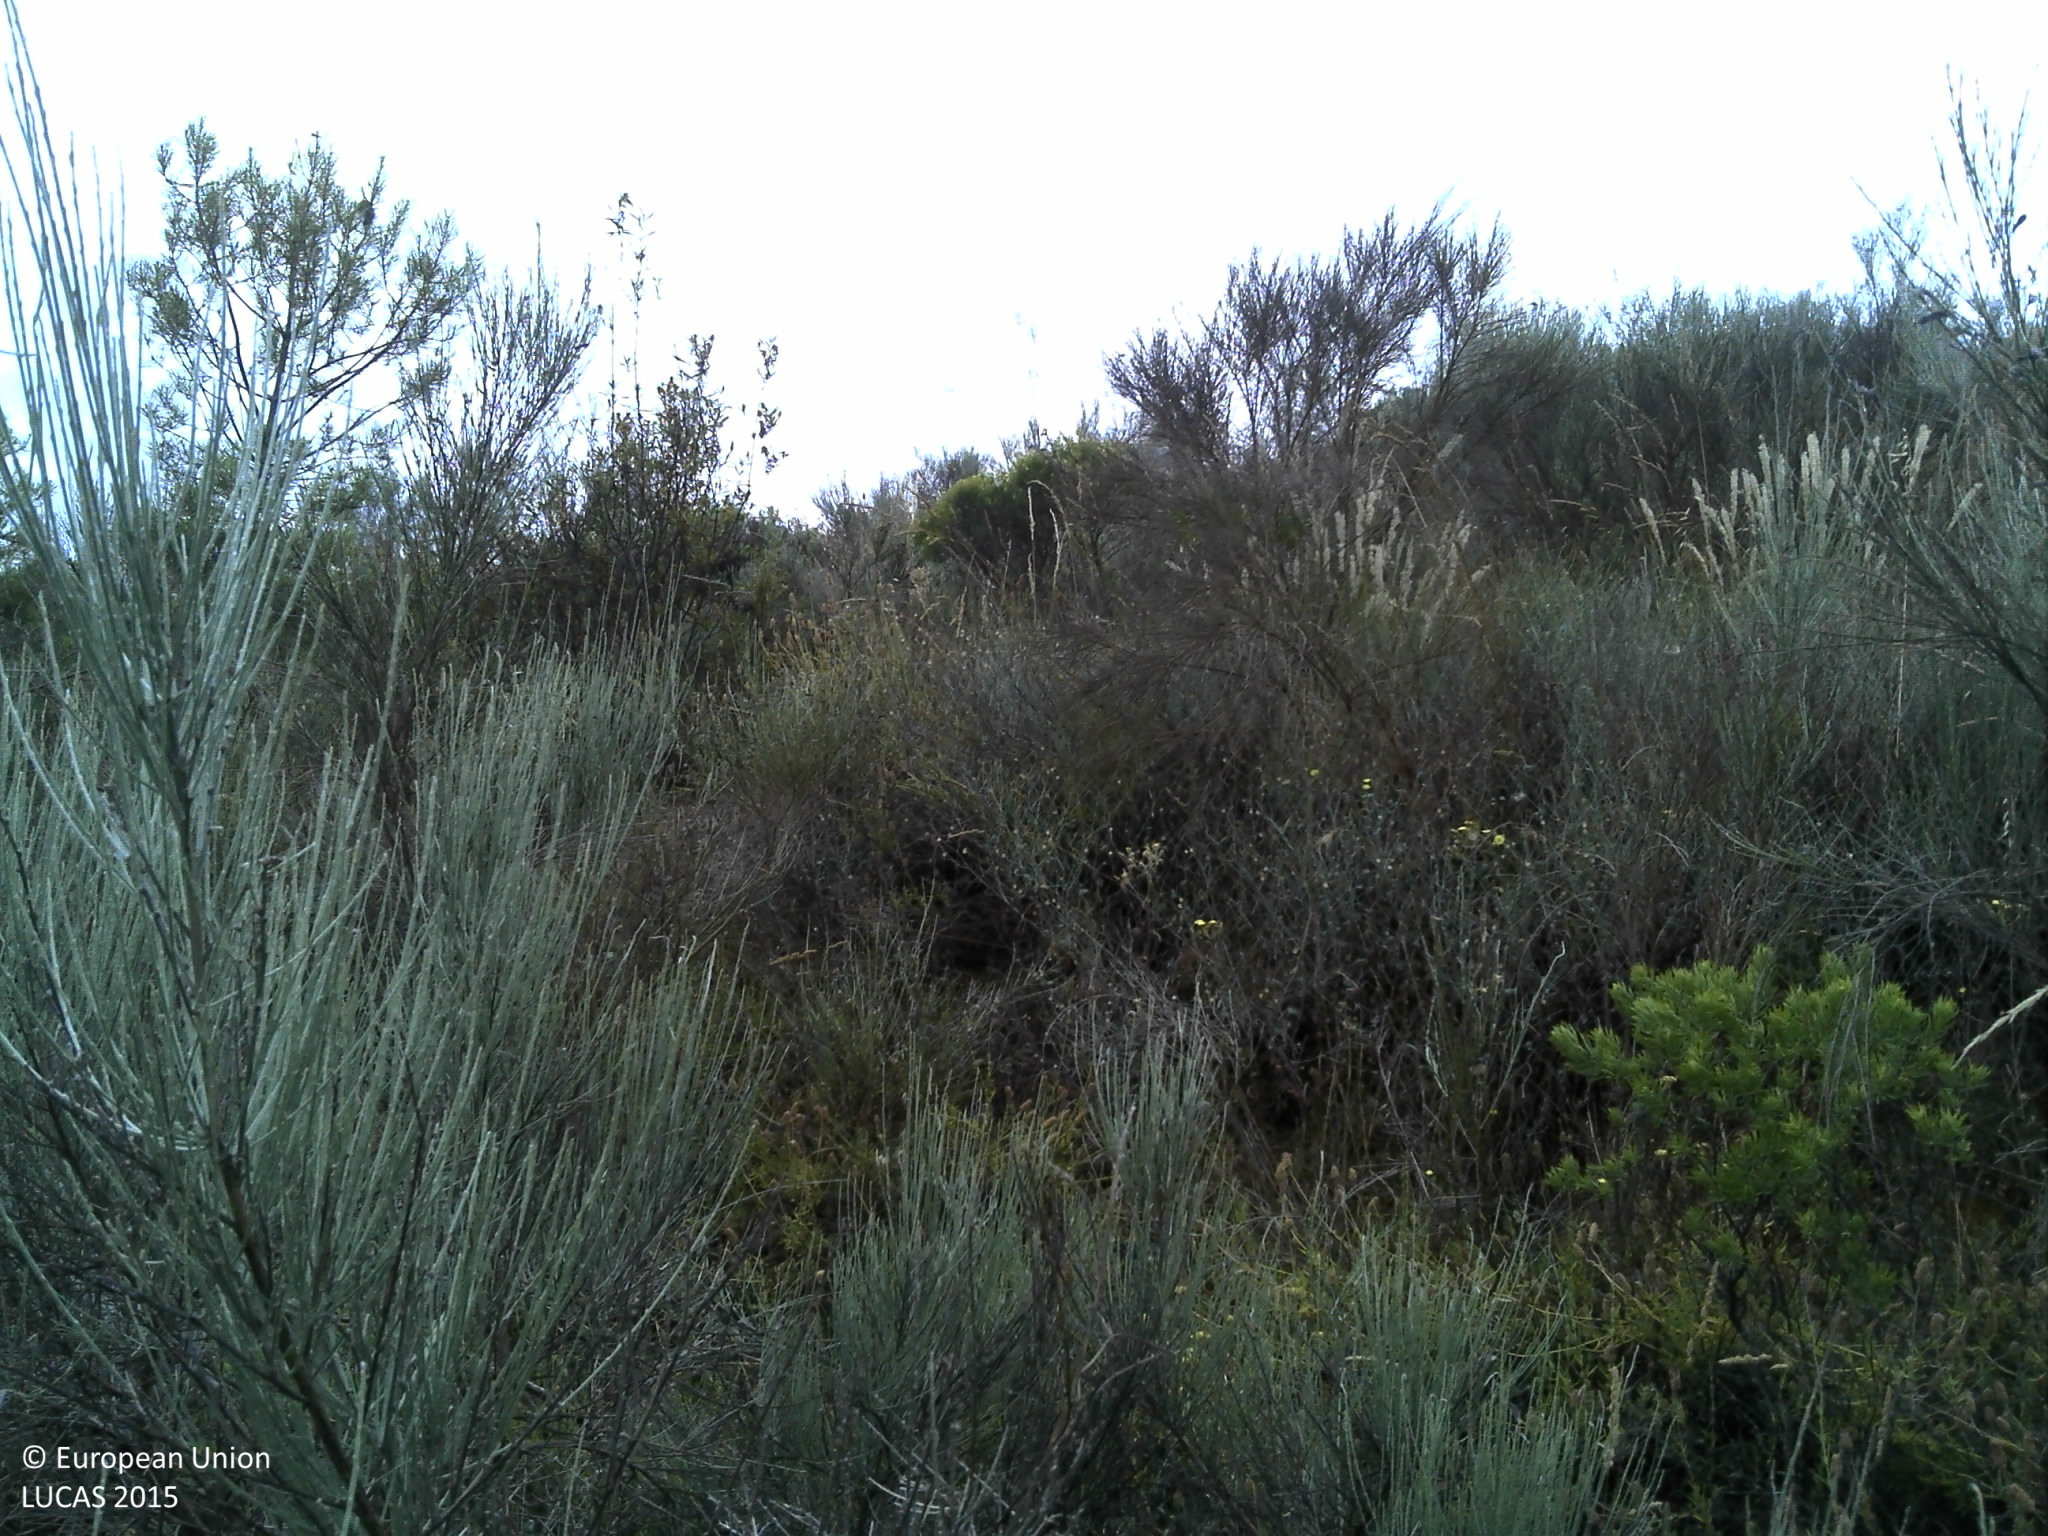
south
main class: Shrubland
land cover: Shrubland with sparse tree cover
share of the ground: > 75 %
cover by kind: shrubs 95 %, coniferous forest trees 5 %
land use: Abandoned areas
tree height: < 5 m
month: June
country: PT
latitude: 41.2855
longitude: -6.9578
